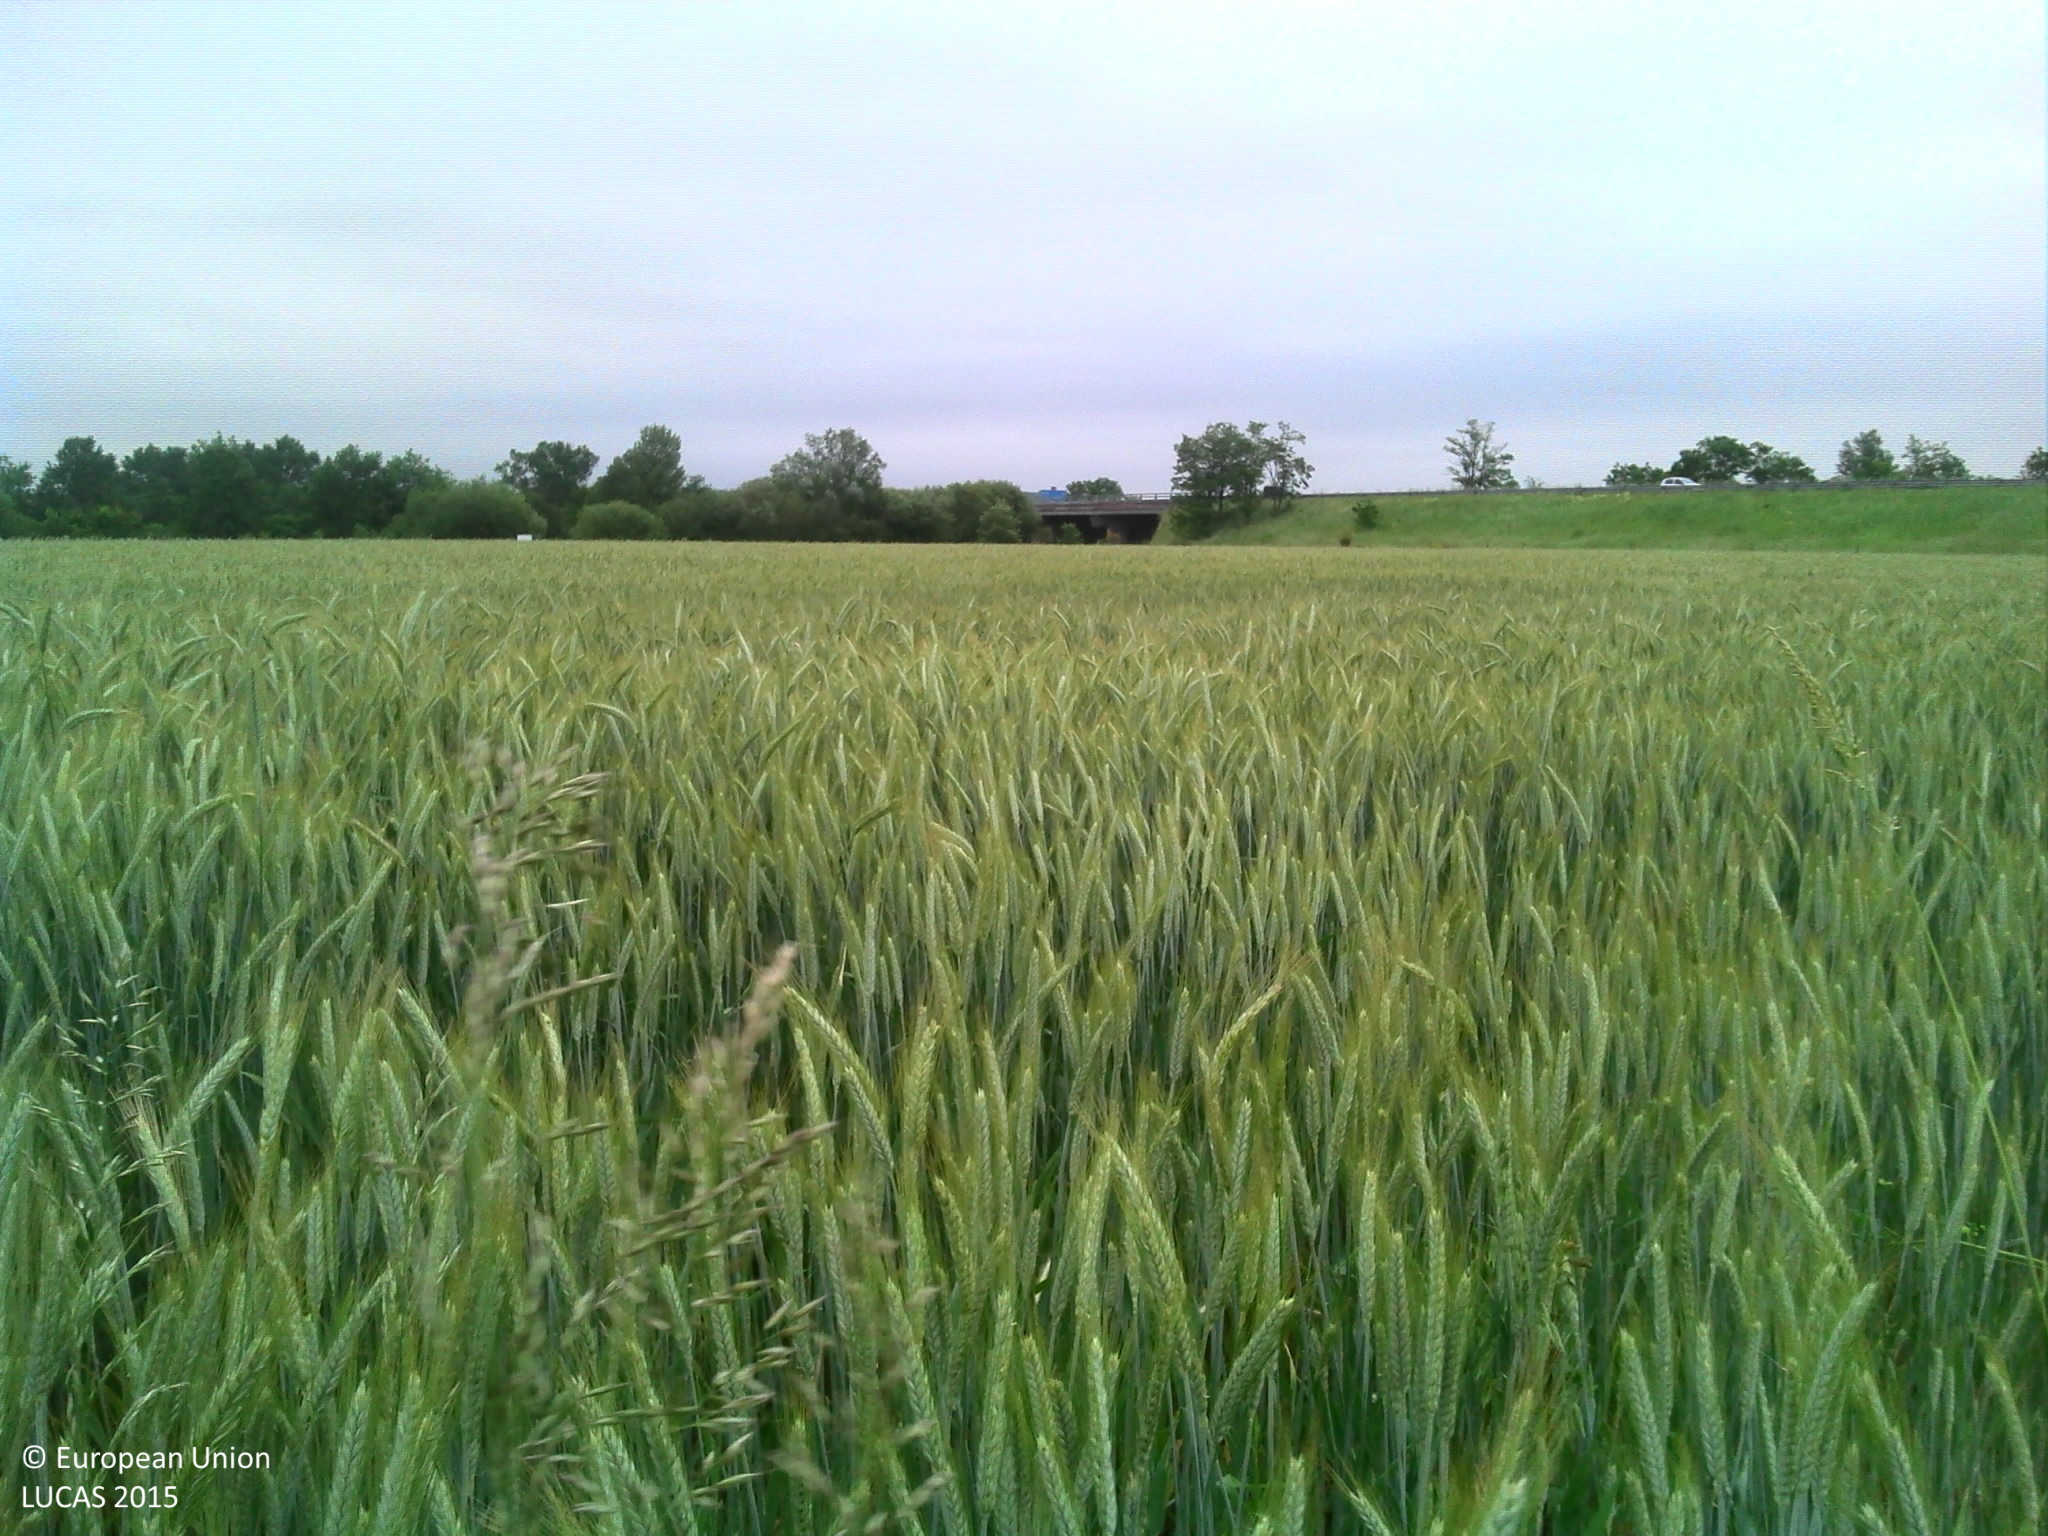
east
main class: Shrubland
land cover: Shrubland with sparse tree cover
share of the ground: > 75 %
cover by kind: shrubs 95 %, broadleaved forest trees 5 %
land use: Fallow land
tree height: < 5 m
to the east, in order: Shrubland with sparse tree cover; Ditches and canals; Grass margins; Barley; Grass margins; Ditches and canals; Fences; Grassland with sparse tree/shrub cover; Paved roads, cycling and walking lanes; Grassland with sparse tree/shrub cover; Fences; Grassland without tree/shrub cover; Paved roads, cycling and walking lanes; Tracks; Managed hedges
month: May
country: FR
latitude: 43.7653
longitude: 1.7175
